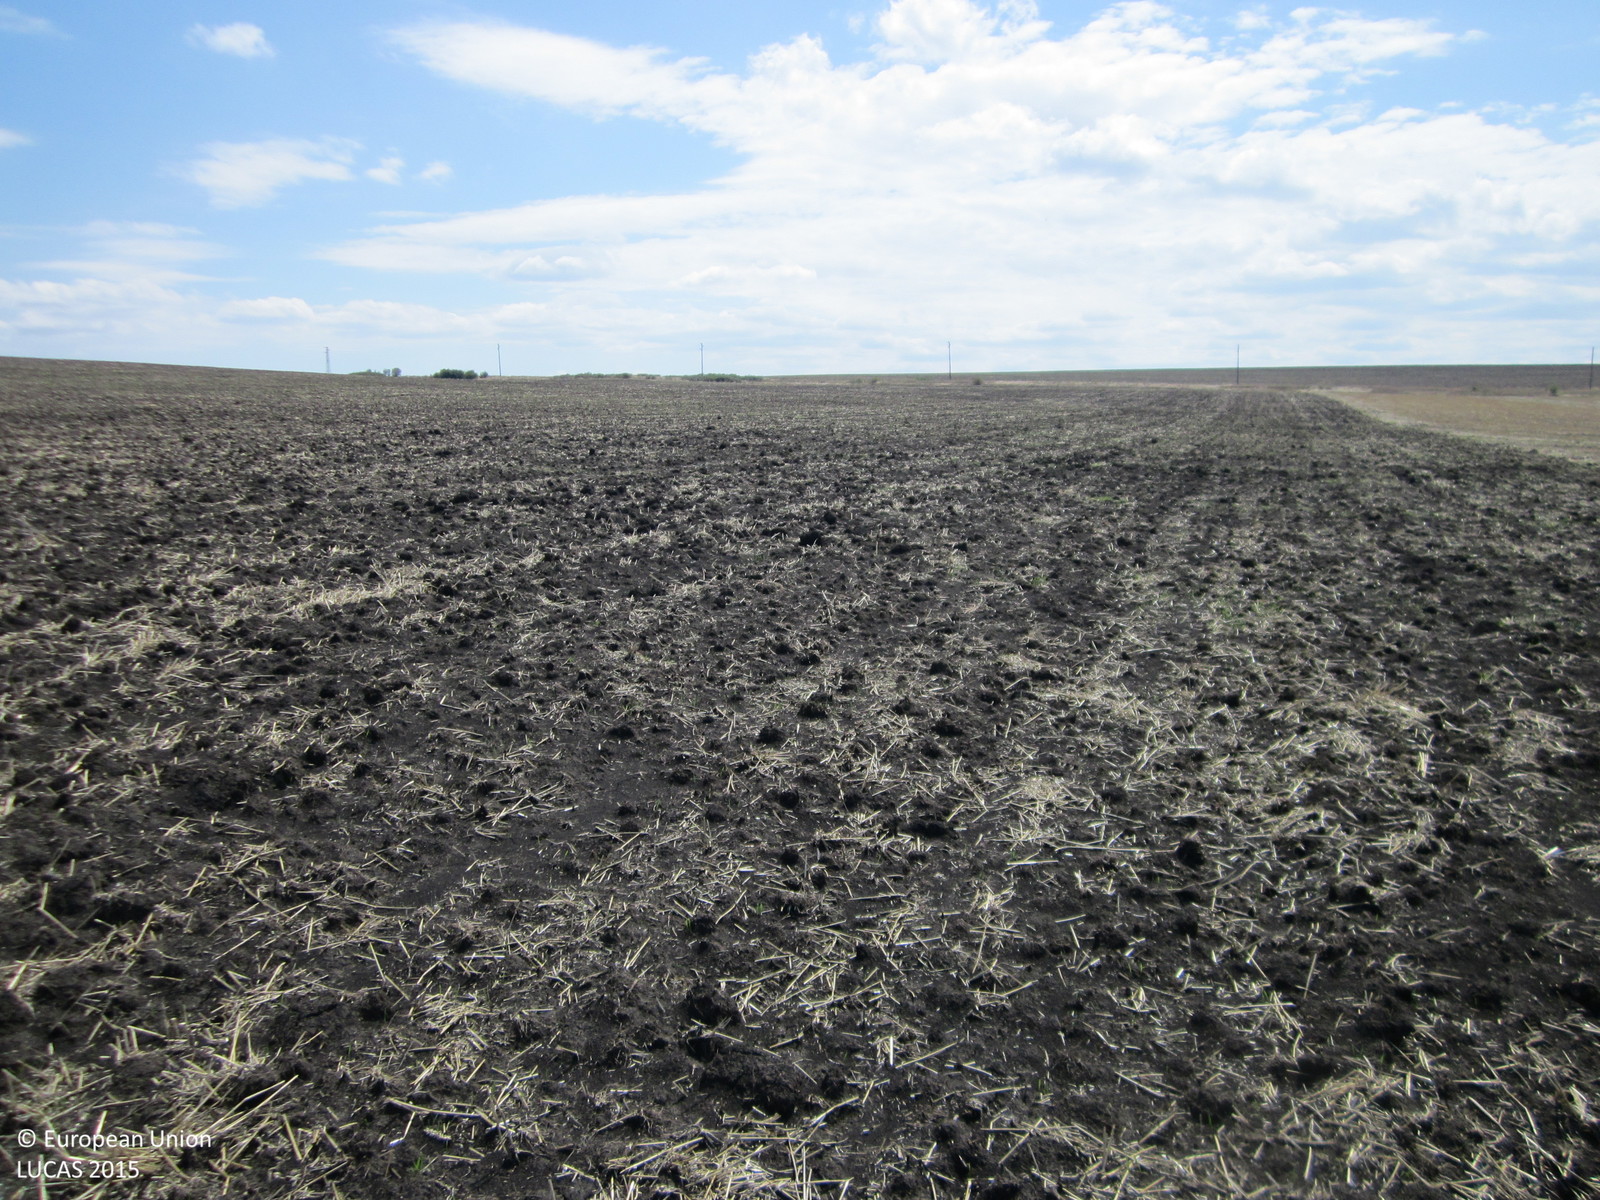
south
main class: Cropland
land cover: Common wheat
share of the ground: 10 - 25 %
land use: Agriculture (excluding fallow land and kitchen gardens)
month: August
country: BG
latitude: 42.5695
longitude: 26.8771
